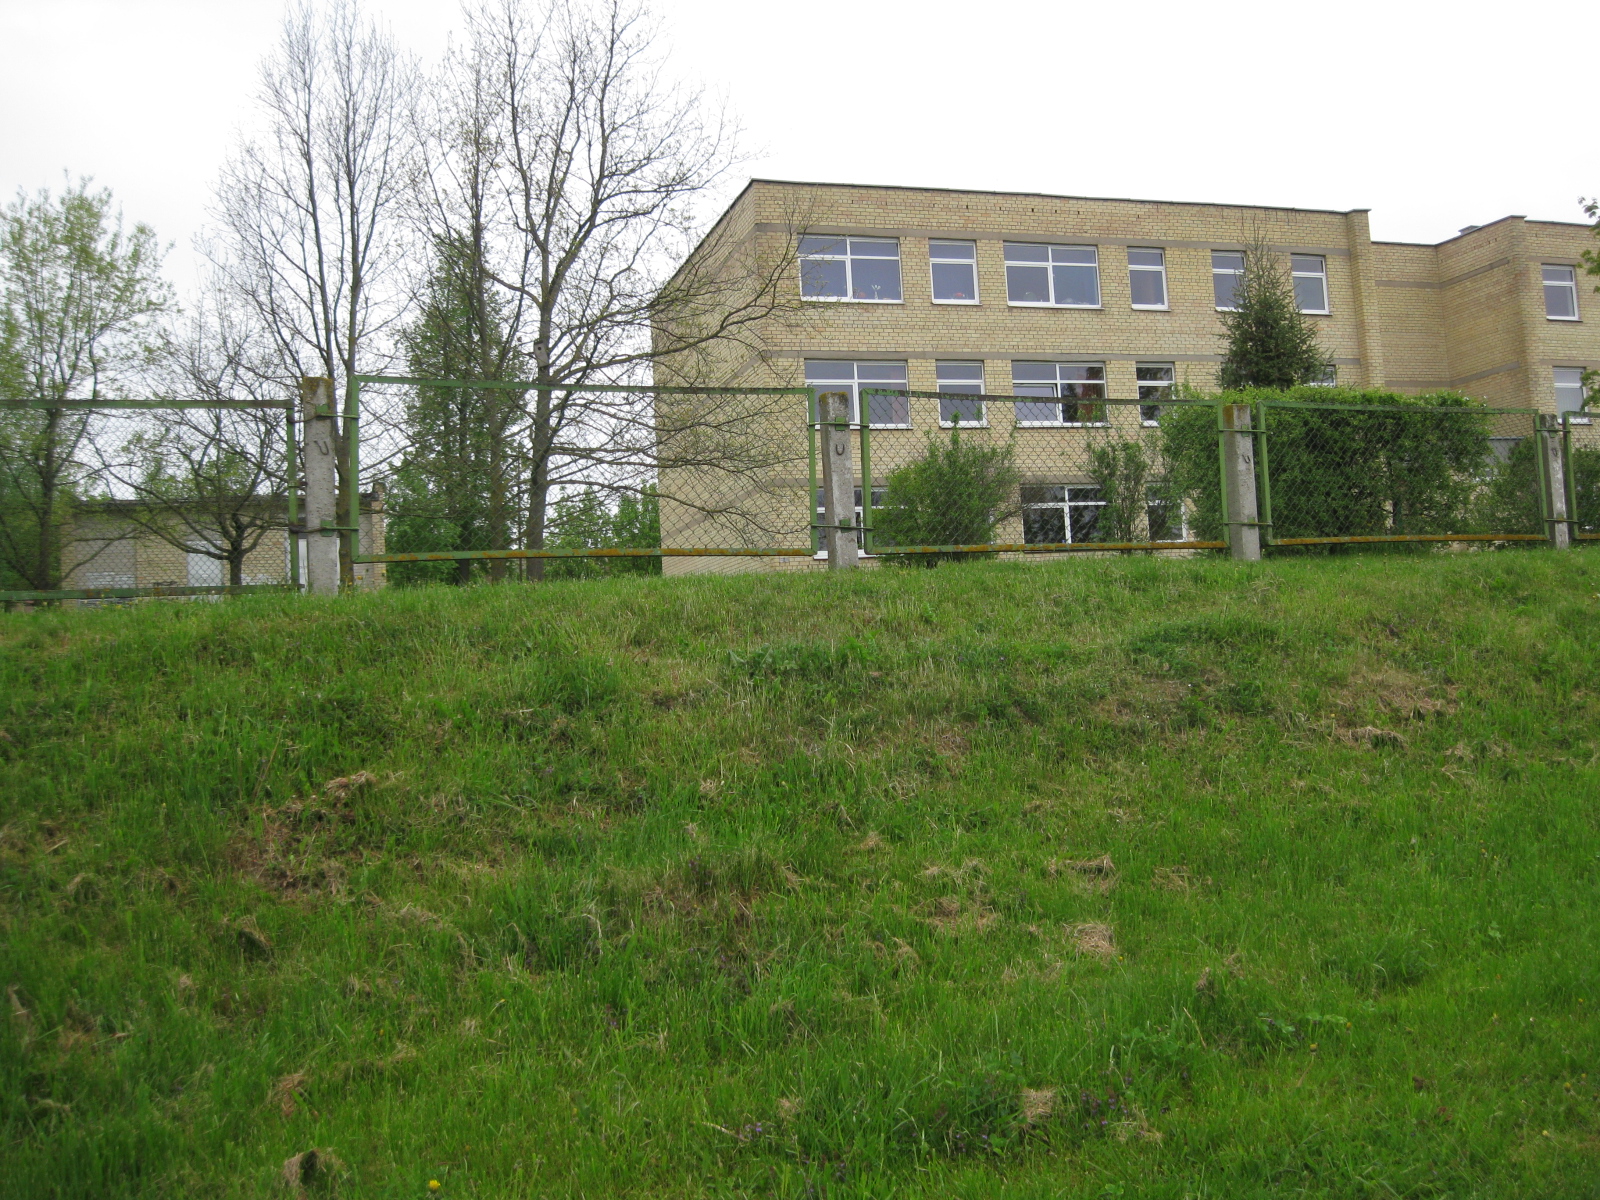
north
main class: Grassland
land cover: Grassland without tree/shrub cover
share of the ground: > 75 %
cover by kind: herbaceous plants 100 %
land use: Amenities, museums, leisure
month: May
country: LT
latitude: 56.0642
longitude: 24.4065
